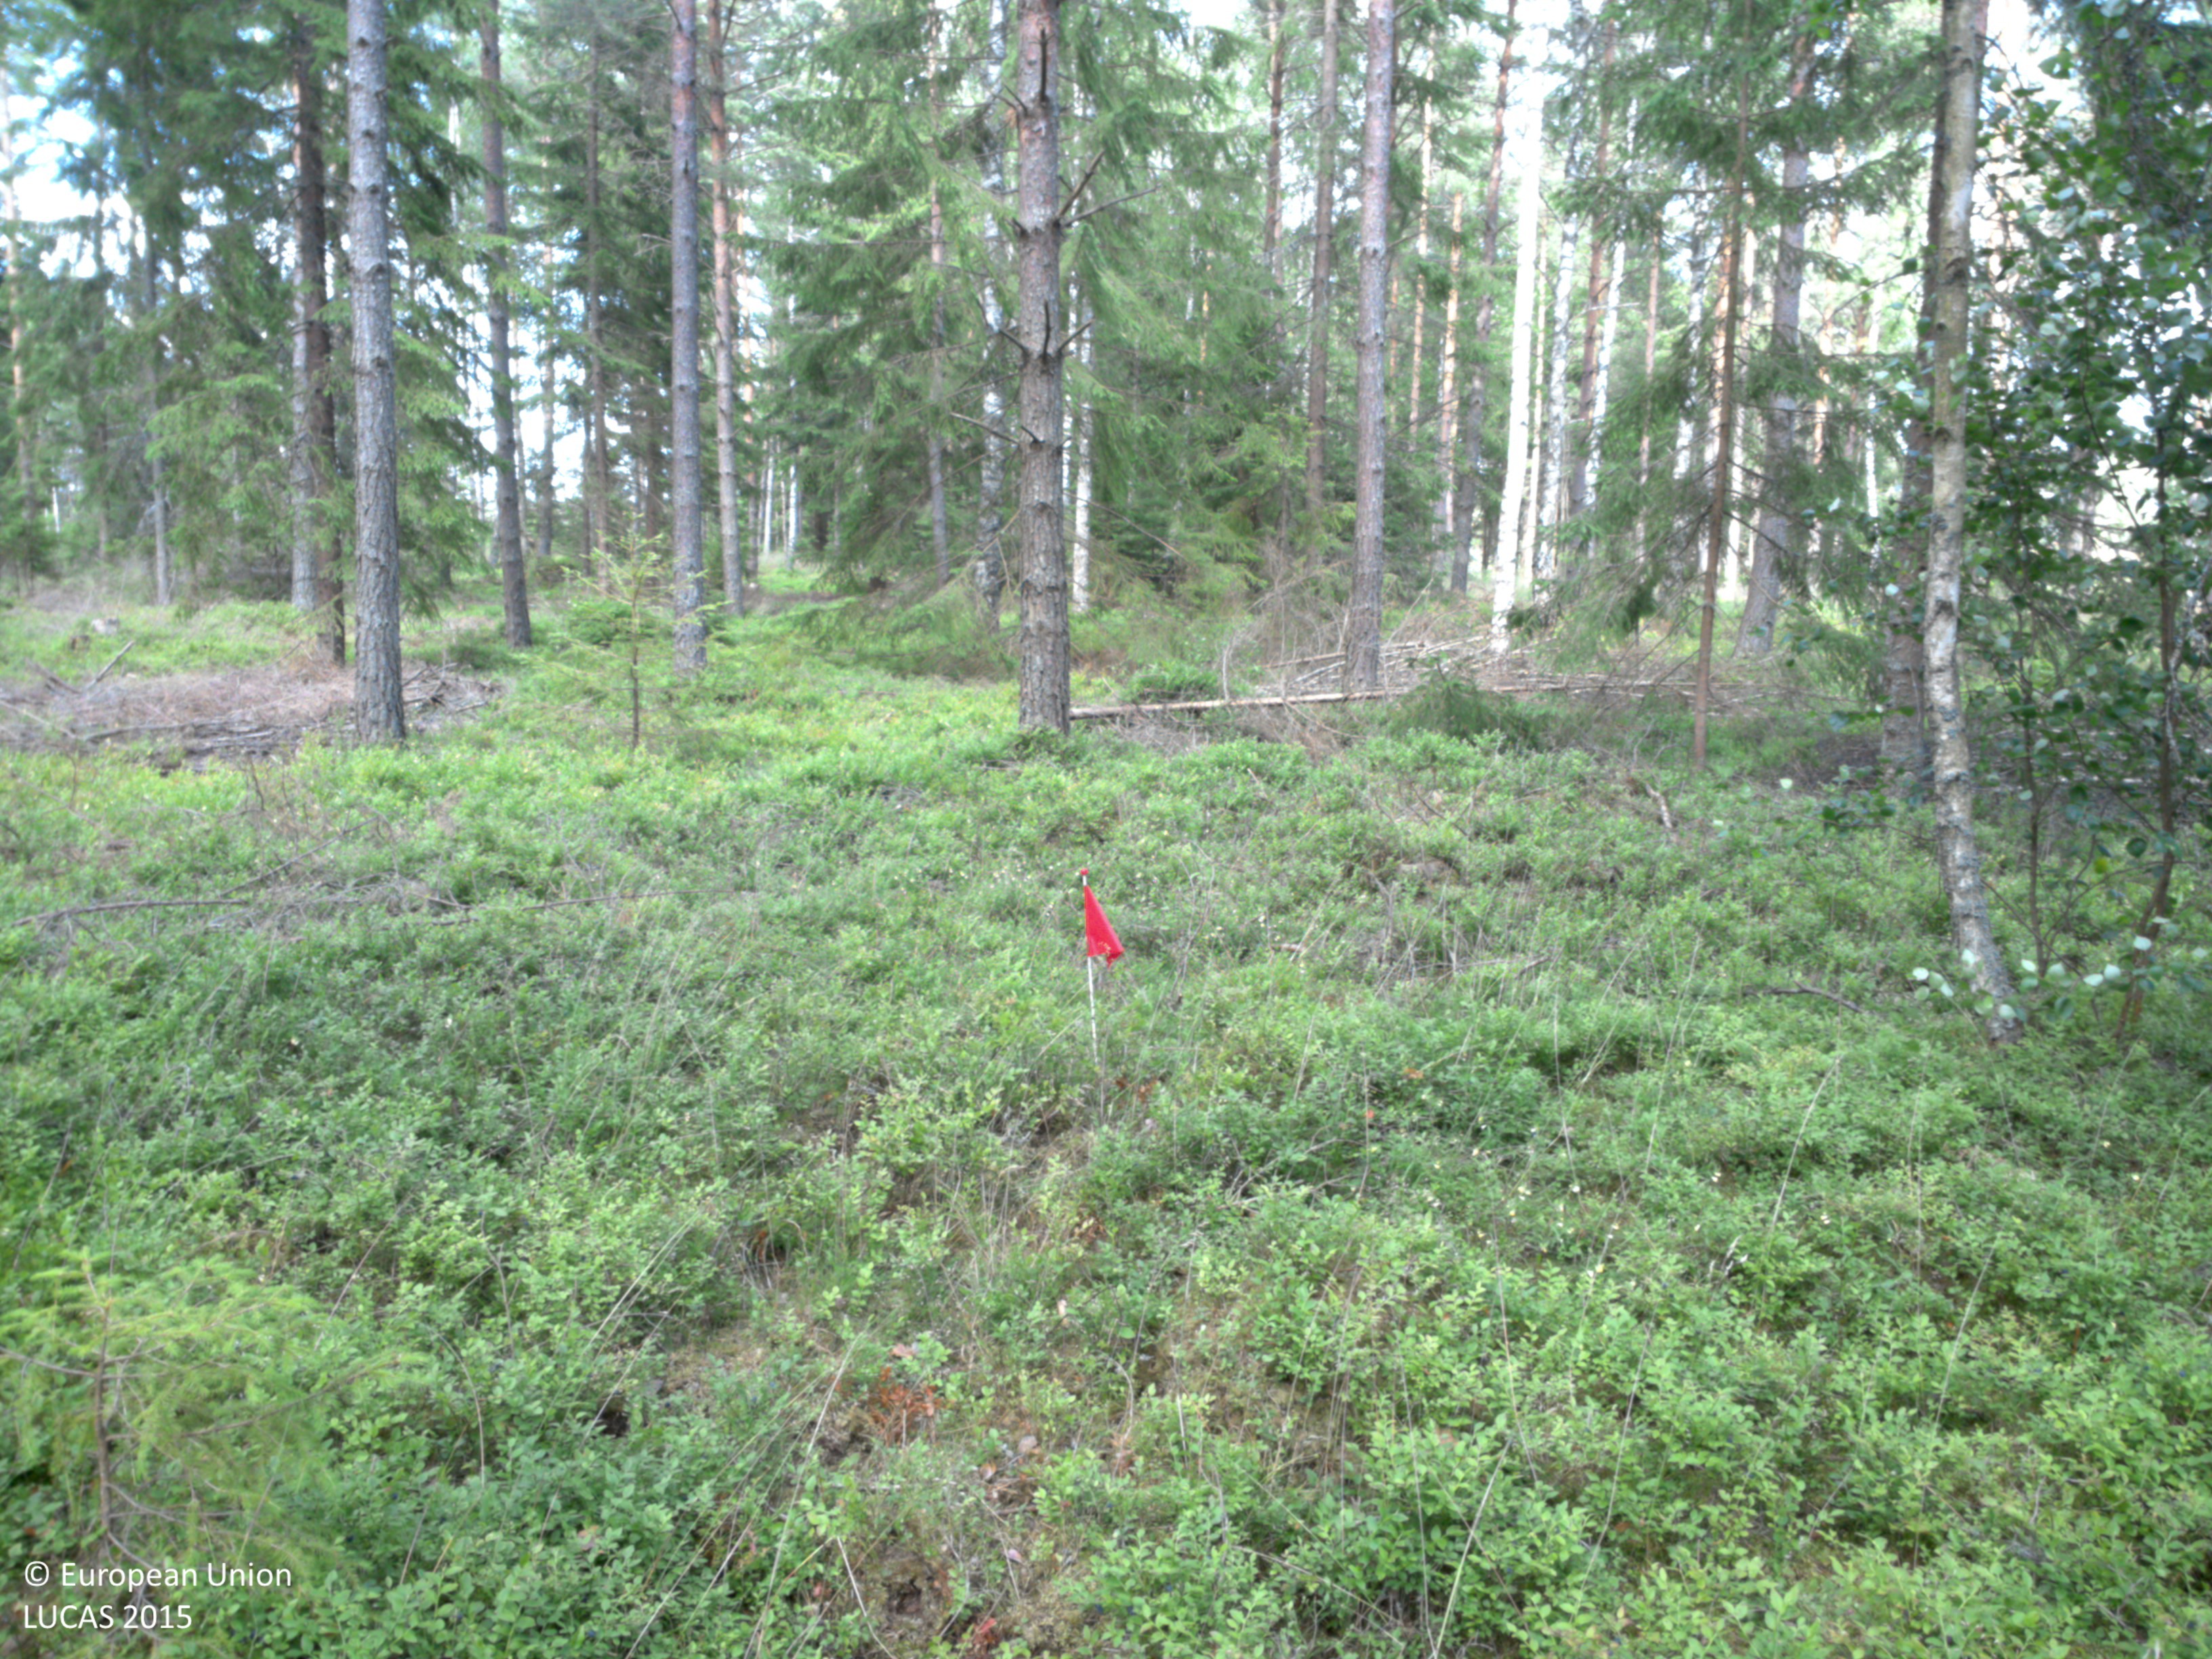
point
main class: Woodland
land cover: Pine dominated coniferous woodland
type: boreal forest
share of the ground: 50 - 75 %
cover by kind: coniferous forest trees 50 %, shrubs 45 %, lichens and mosses 5 %
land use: Forestry
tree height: > 5 m
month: July
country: SE
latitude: 58.2681
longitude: 14.0001
